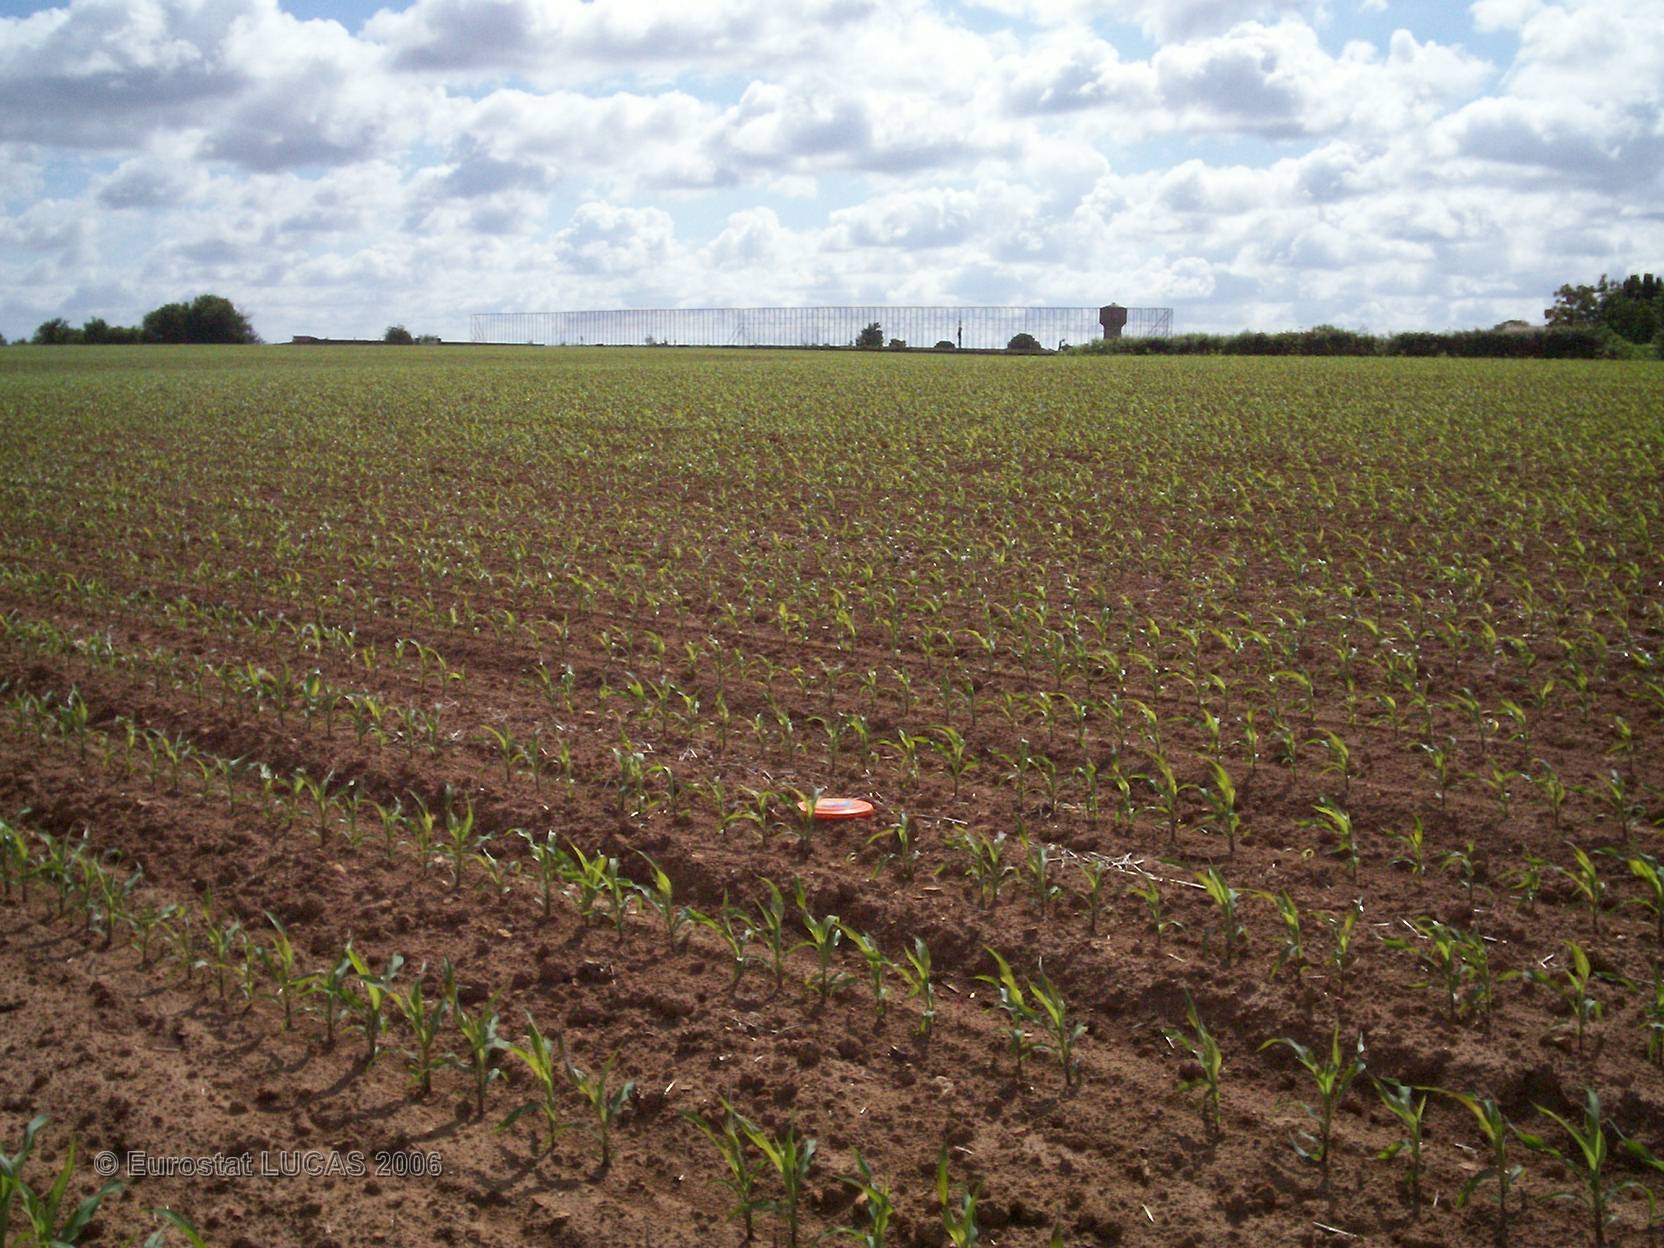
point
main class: Cropland
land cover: Maize
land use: Agriculture (excluding fallow land and kitchen gardens)
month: May
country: FR
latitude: 46.2075
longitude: -0.1965
